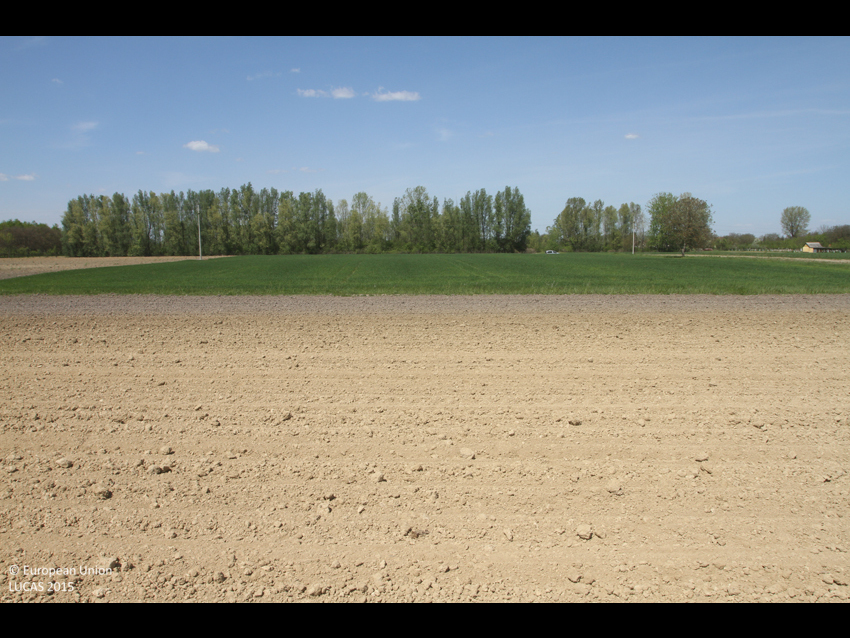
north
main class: Cropland
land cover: Soya
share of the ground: < 10 %
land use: Agriculture (excluding fallow land and kitchen gardens)
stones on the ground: < 10 %
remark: Tilled/Sowed
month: April
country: HR
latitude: 44.8738
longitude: 18.9045
